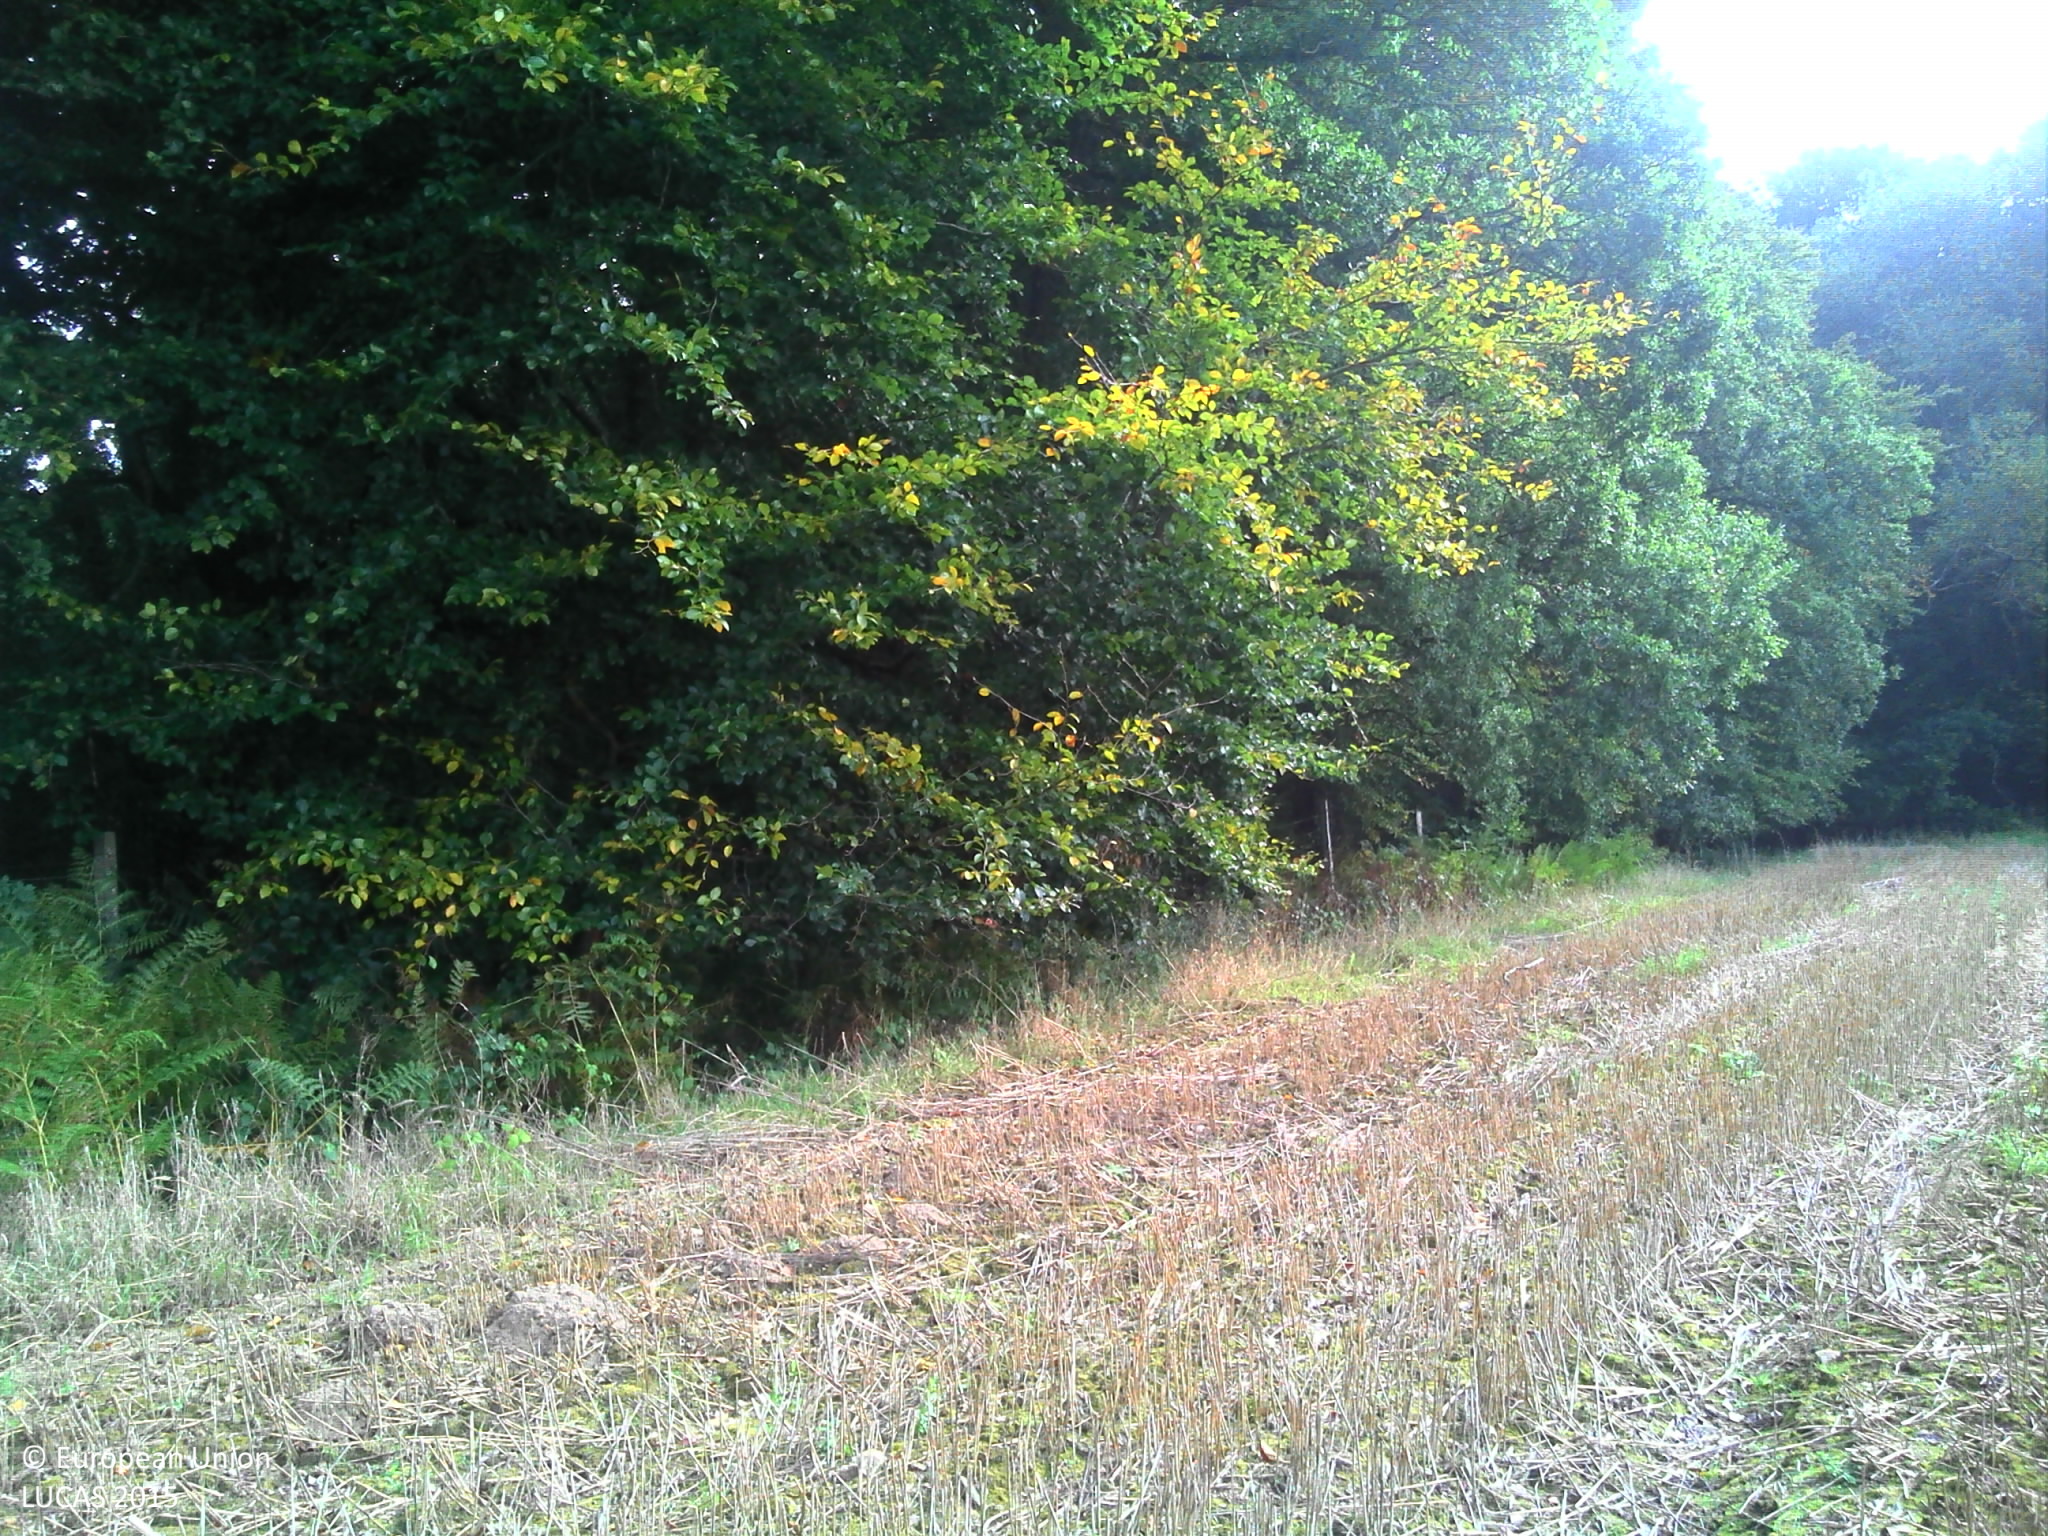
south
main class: Woodland
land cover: Broadleaved woodland
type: beech forest
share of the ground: > 75 %
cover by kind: broadleaved forest trees 100 %
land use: Forestry
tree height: > 5 m
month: October
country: FR
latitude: 48.5234
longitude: -3.1661
